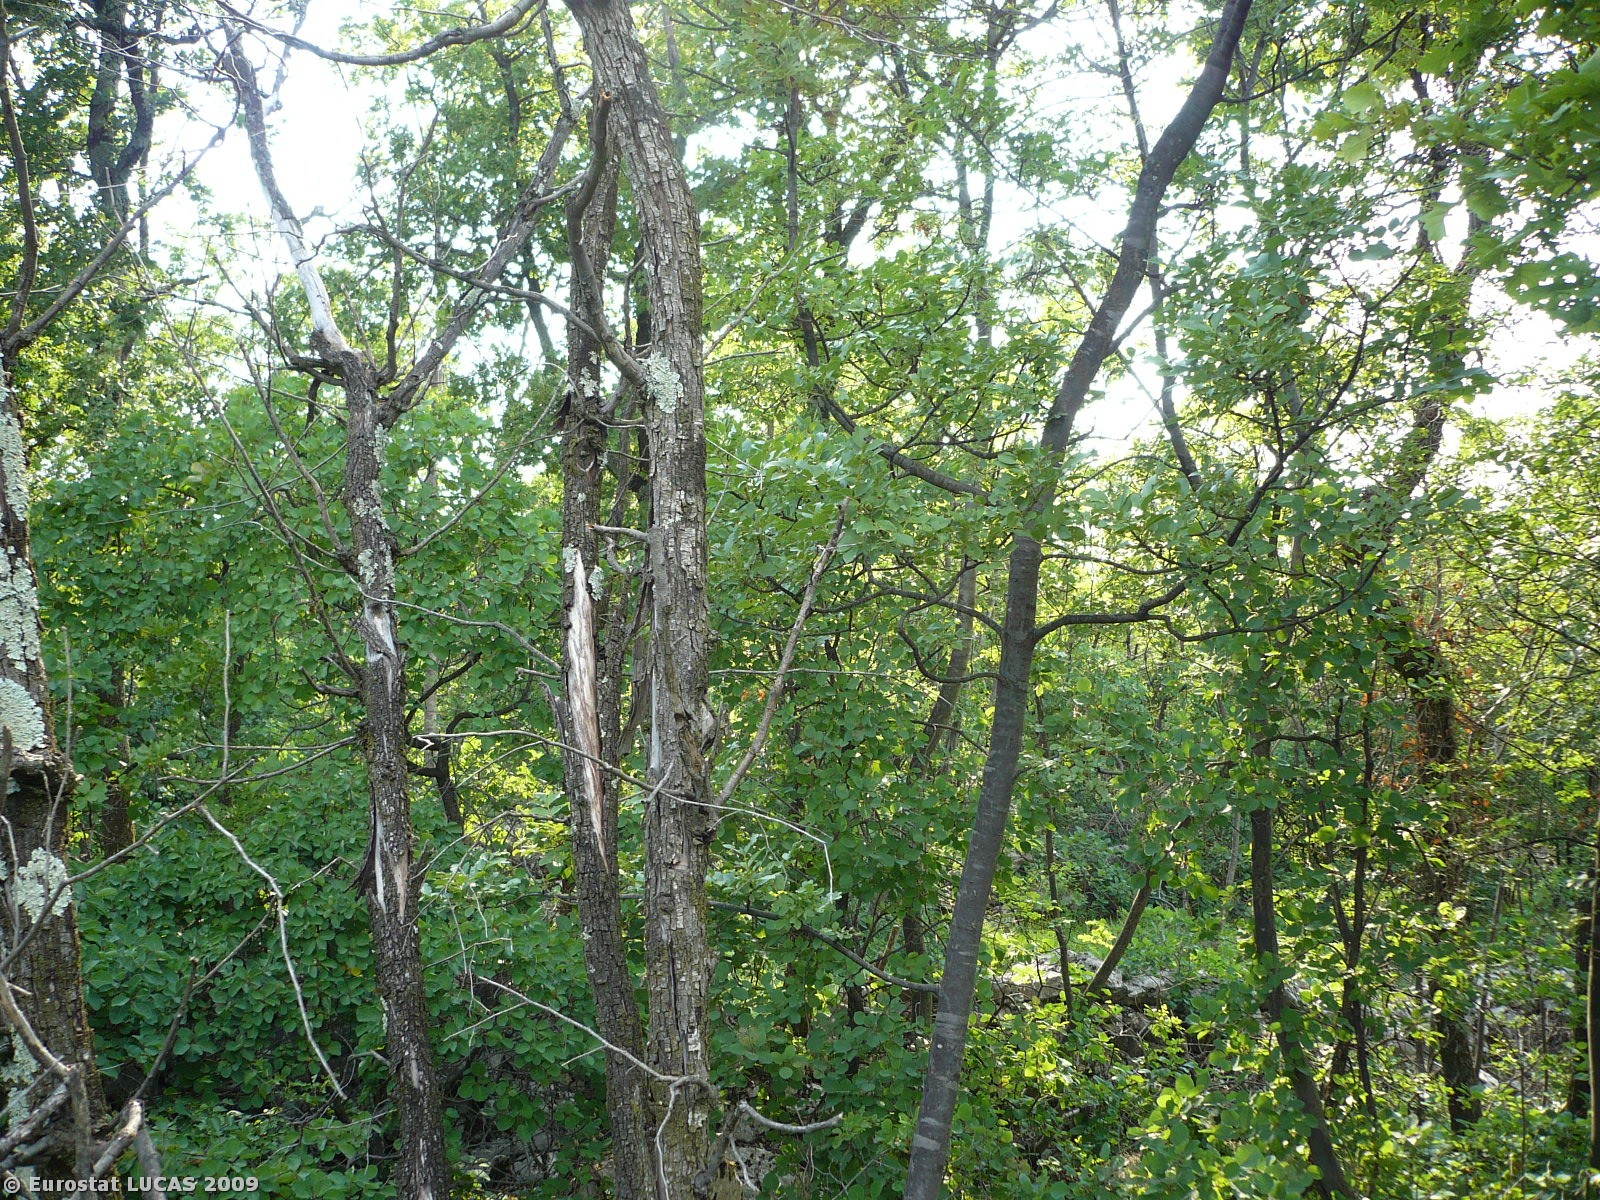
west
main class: Woodland
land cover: Broadleaved woodland
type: thermophilous deciduous forest
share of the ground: > 75 %
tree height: > 5 m
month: July
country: SI
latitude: 45.8016
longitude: 13.6628
